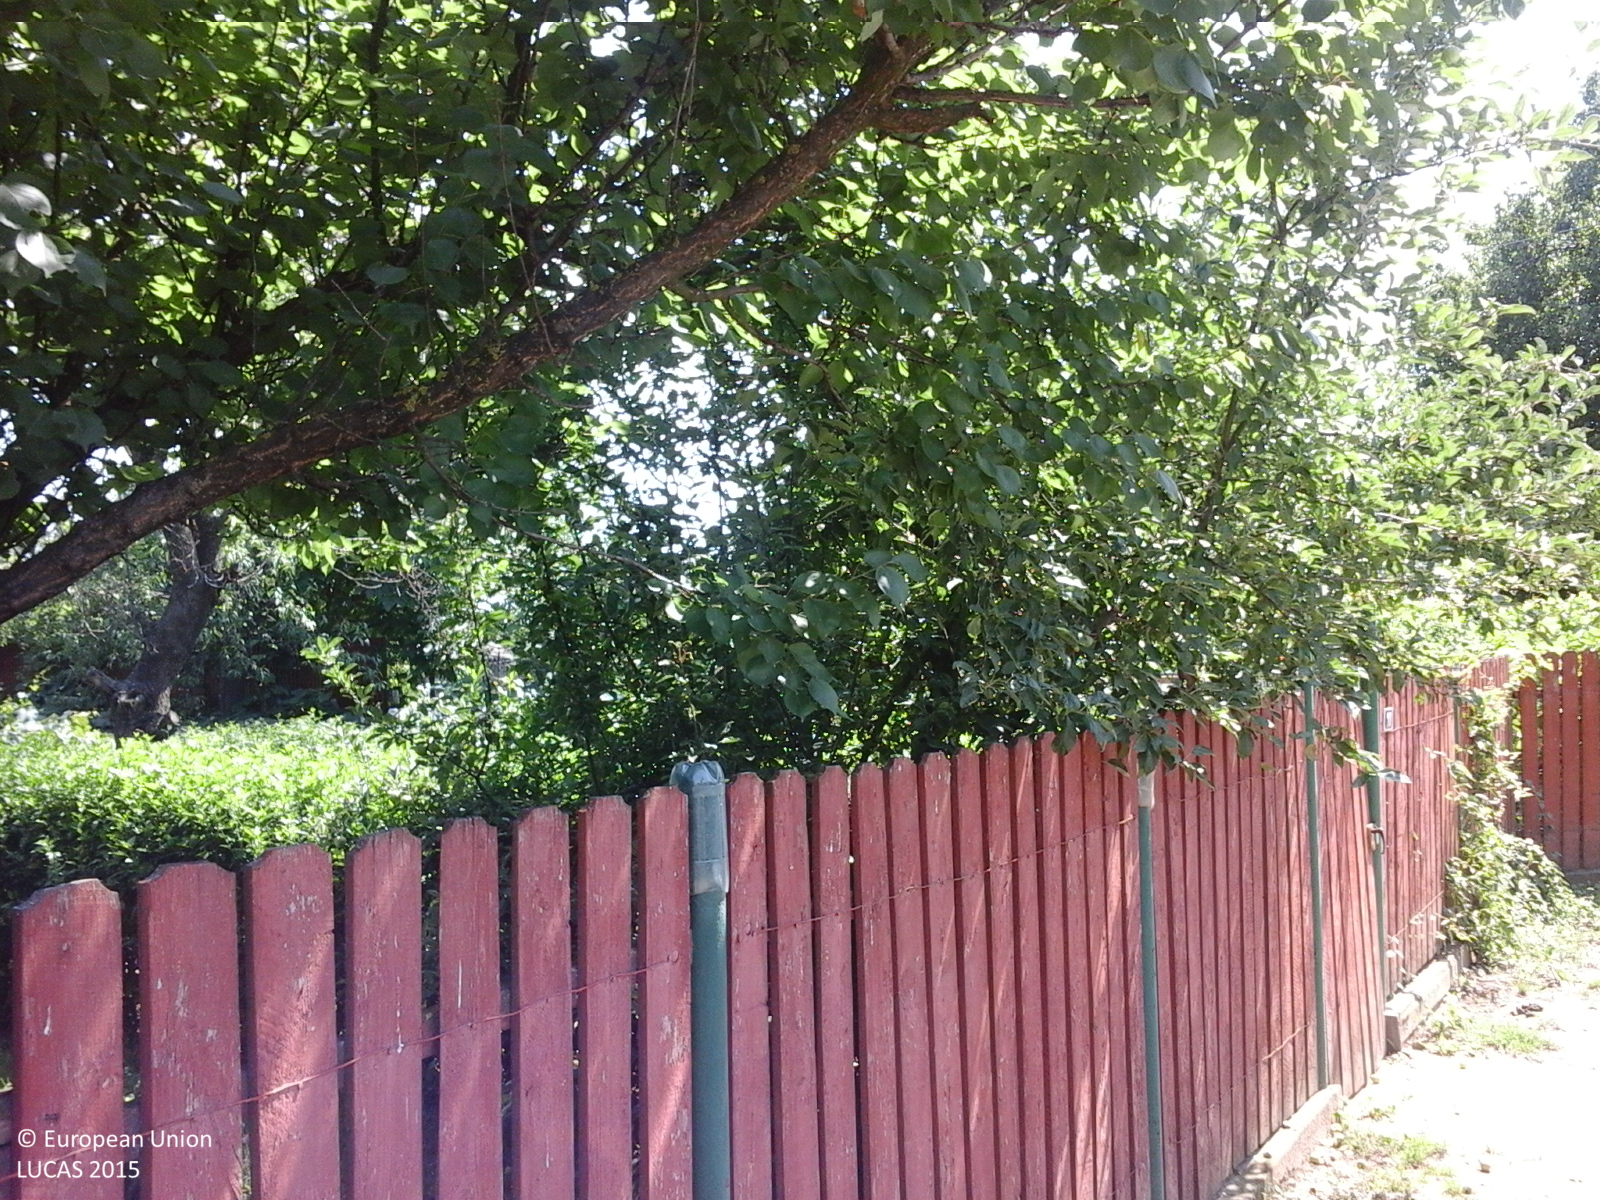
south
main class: Cropland
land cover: Apple fruit
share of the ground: 50 - 75 %
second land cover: Grassland without tree/shrub cover
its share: > 75 %
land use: Agriculture (excluding fallow land and kitchen gardens)
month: July
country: RO
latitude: 43.8976
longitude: 25.9439
